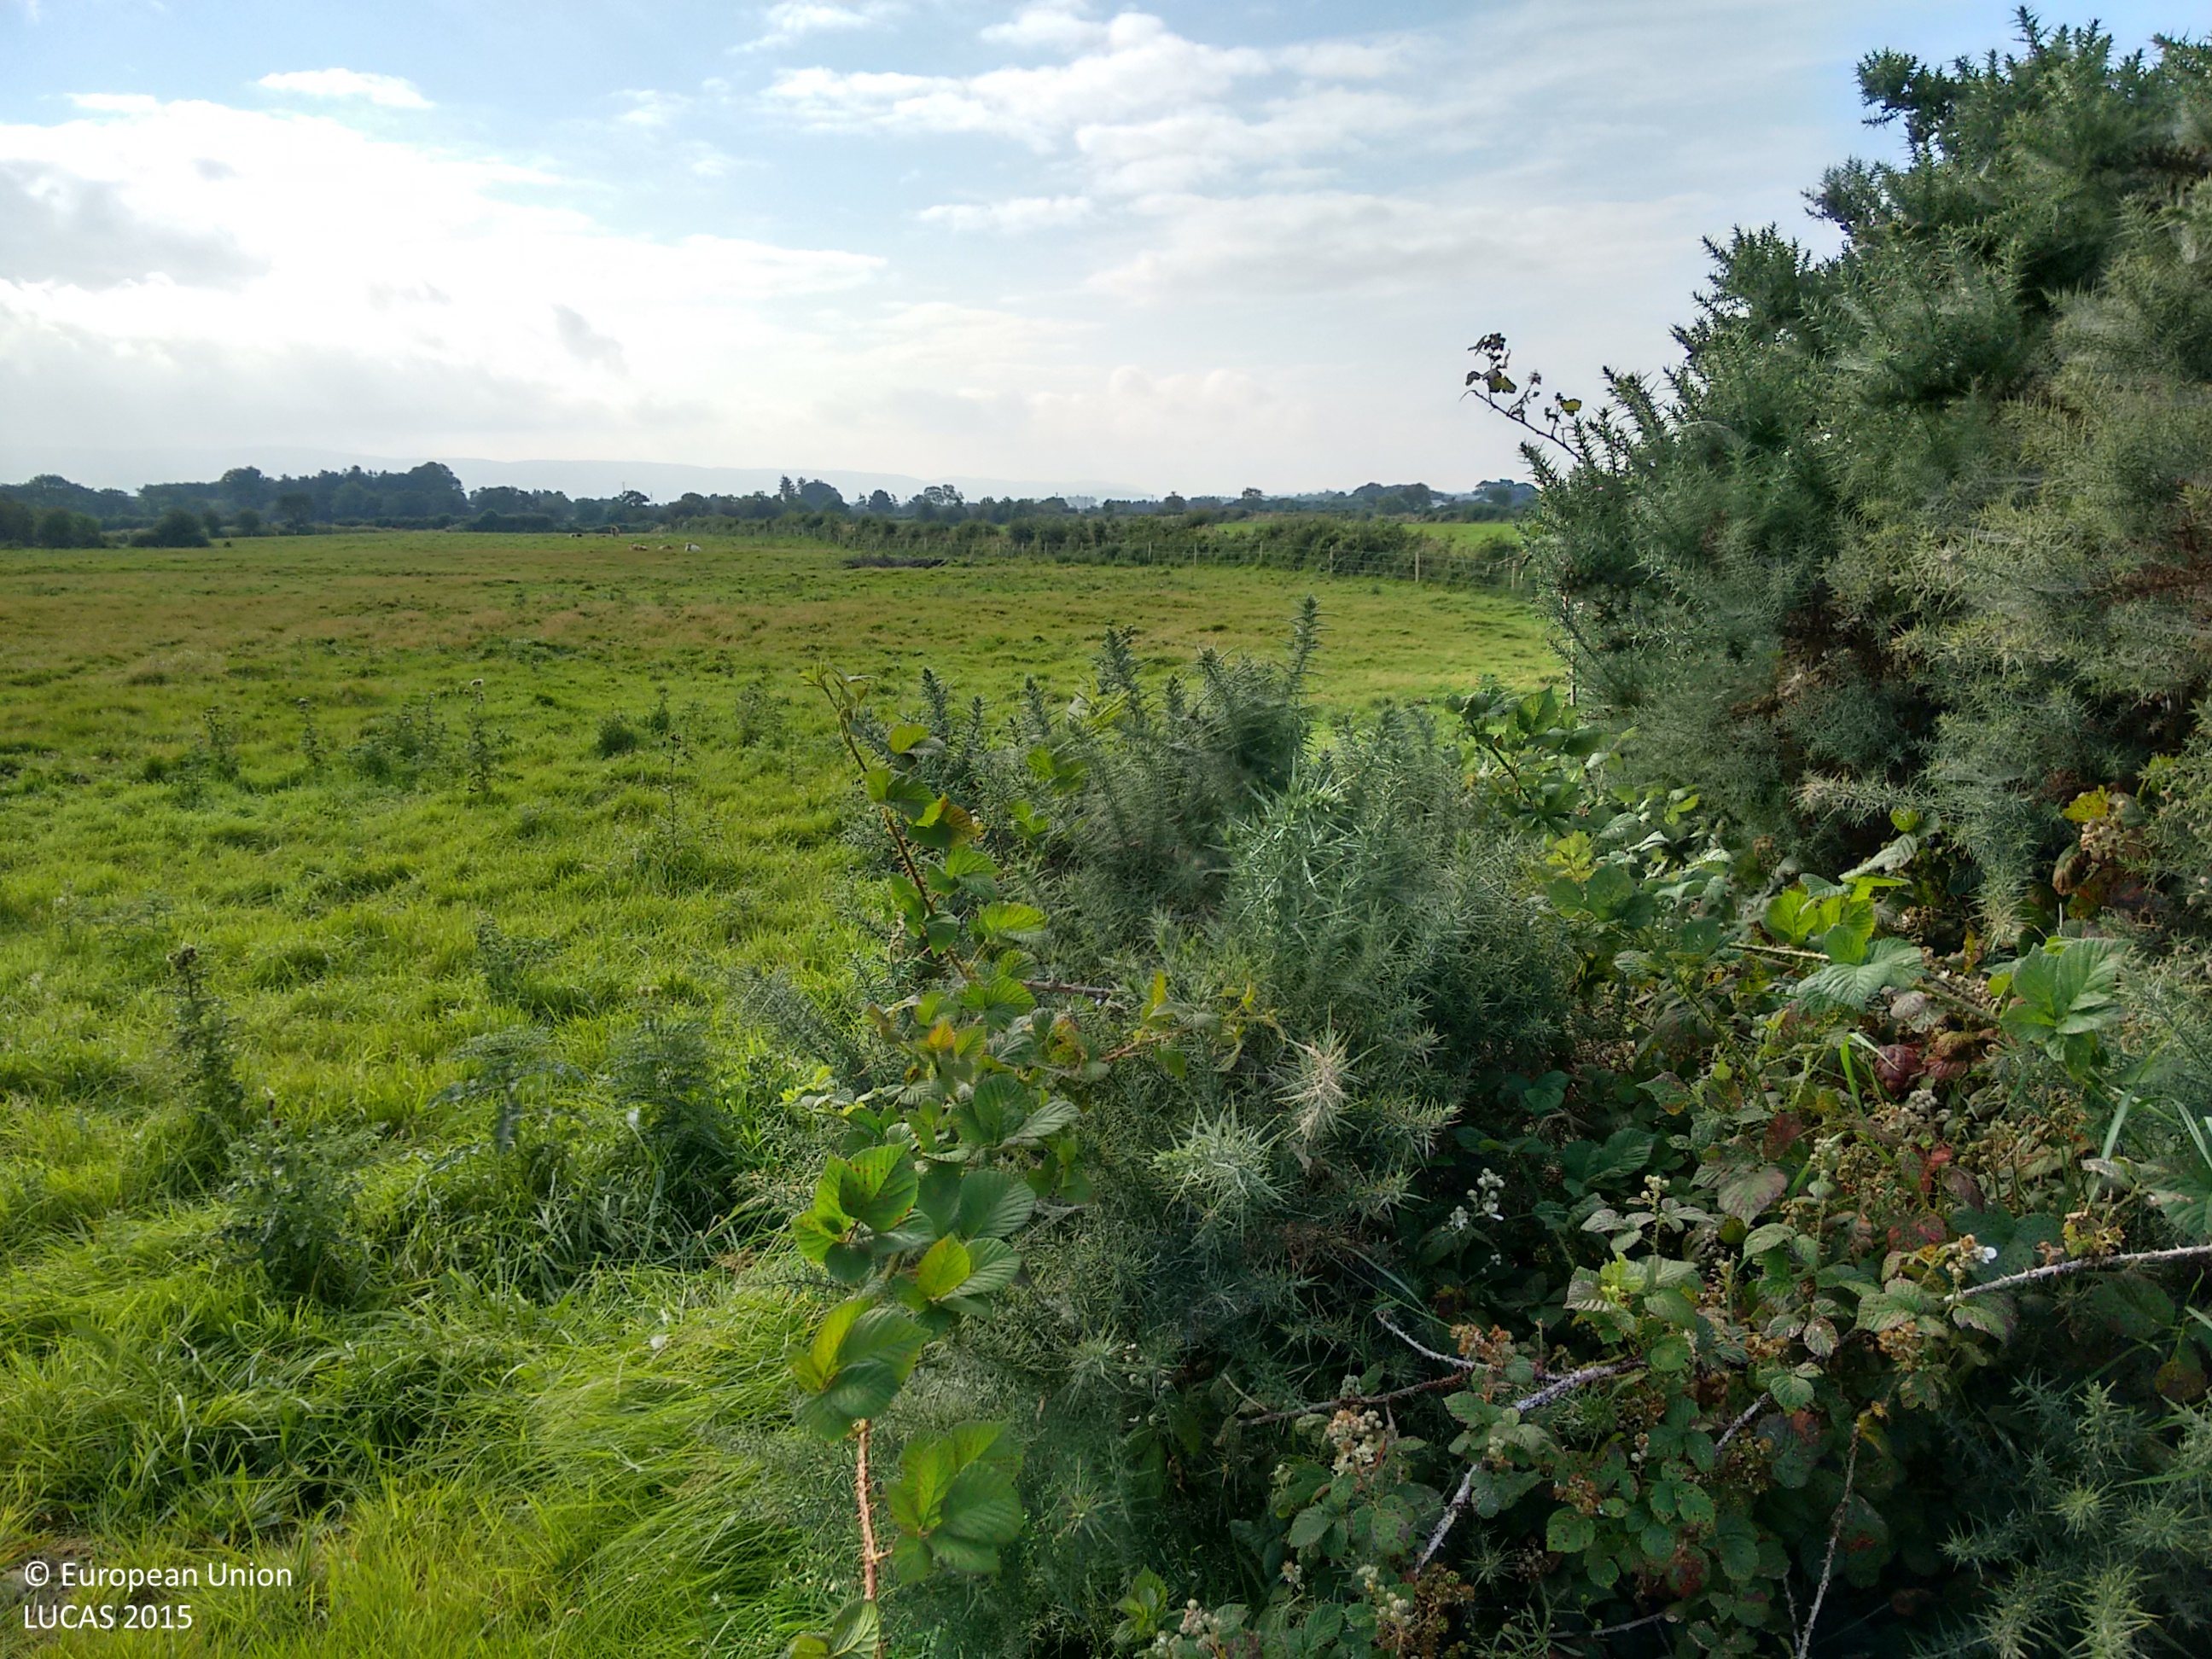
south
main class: Grassland
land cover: Grassland without tree/shrub cover
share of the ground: > 75 %
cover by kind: herbaceous plants 100 %
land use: Agriculture (excluding fallow land and kitchen gardens)
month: September
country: IE
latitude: 54.1226
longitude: -9.0802
